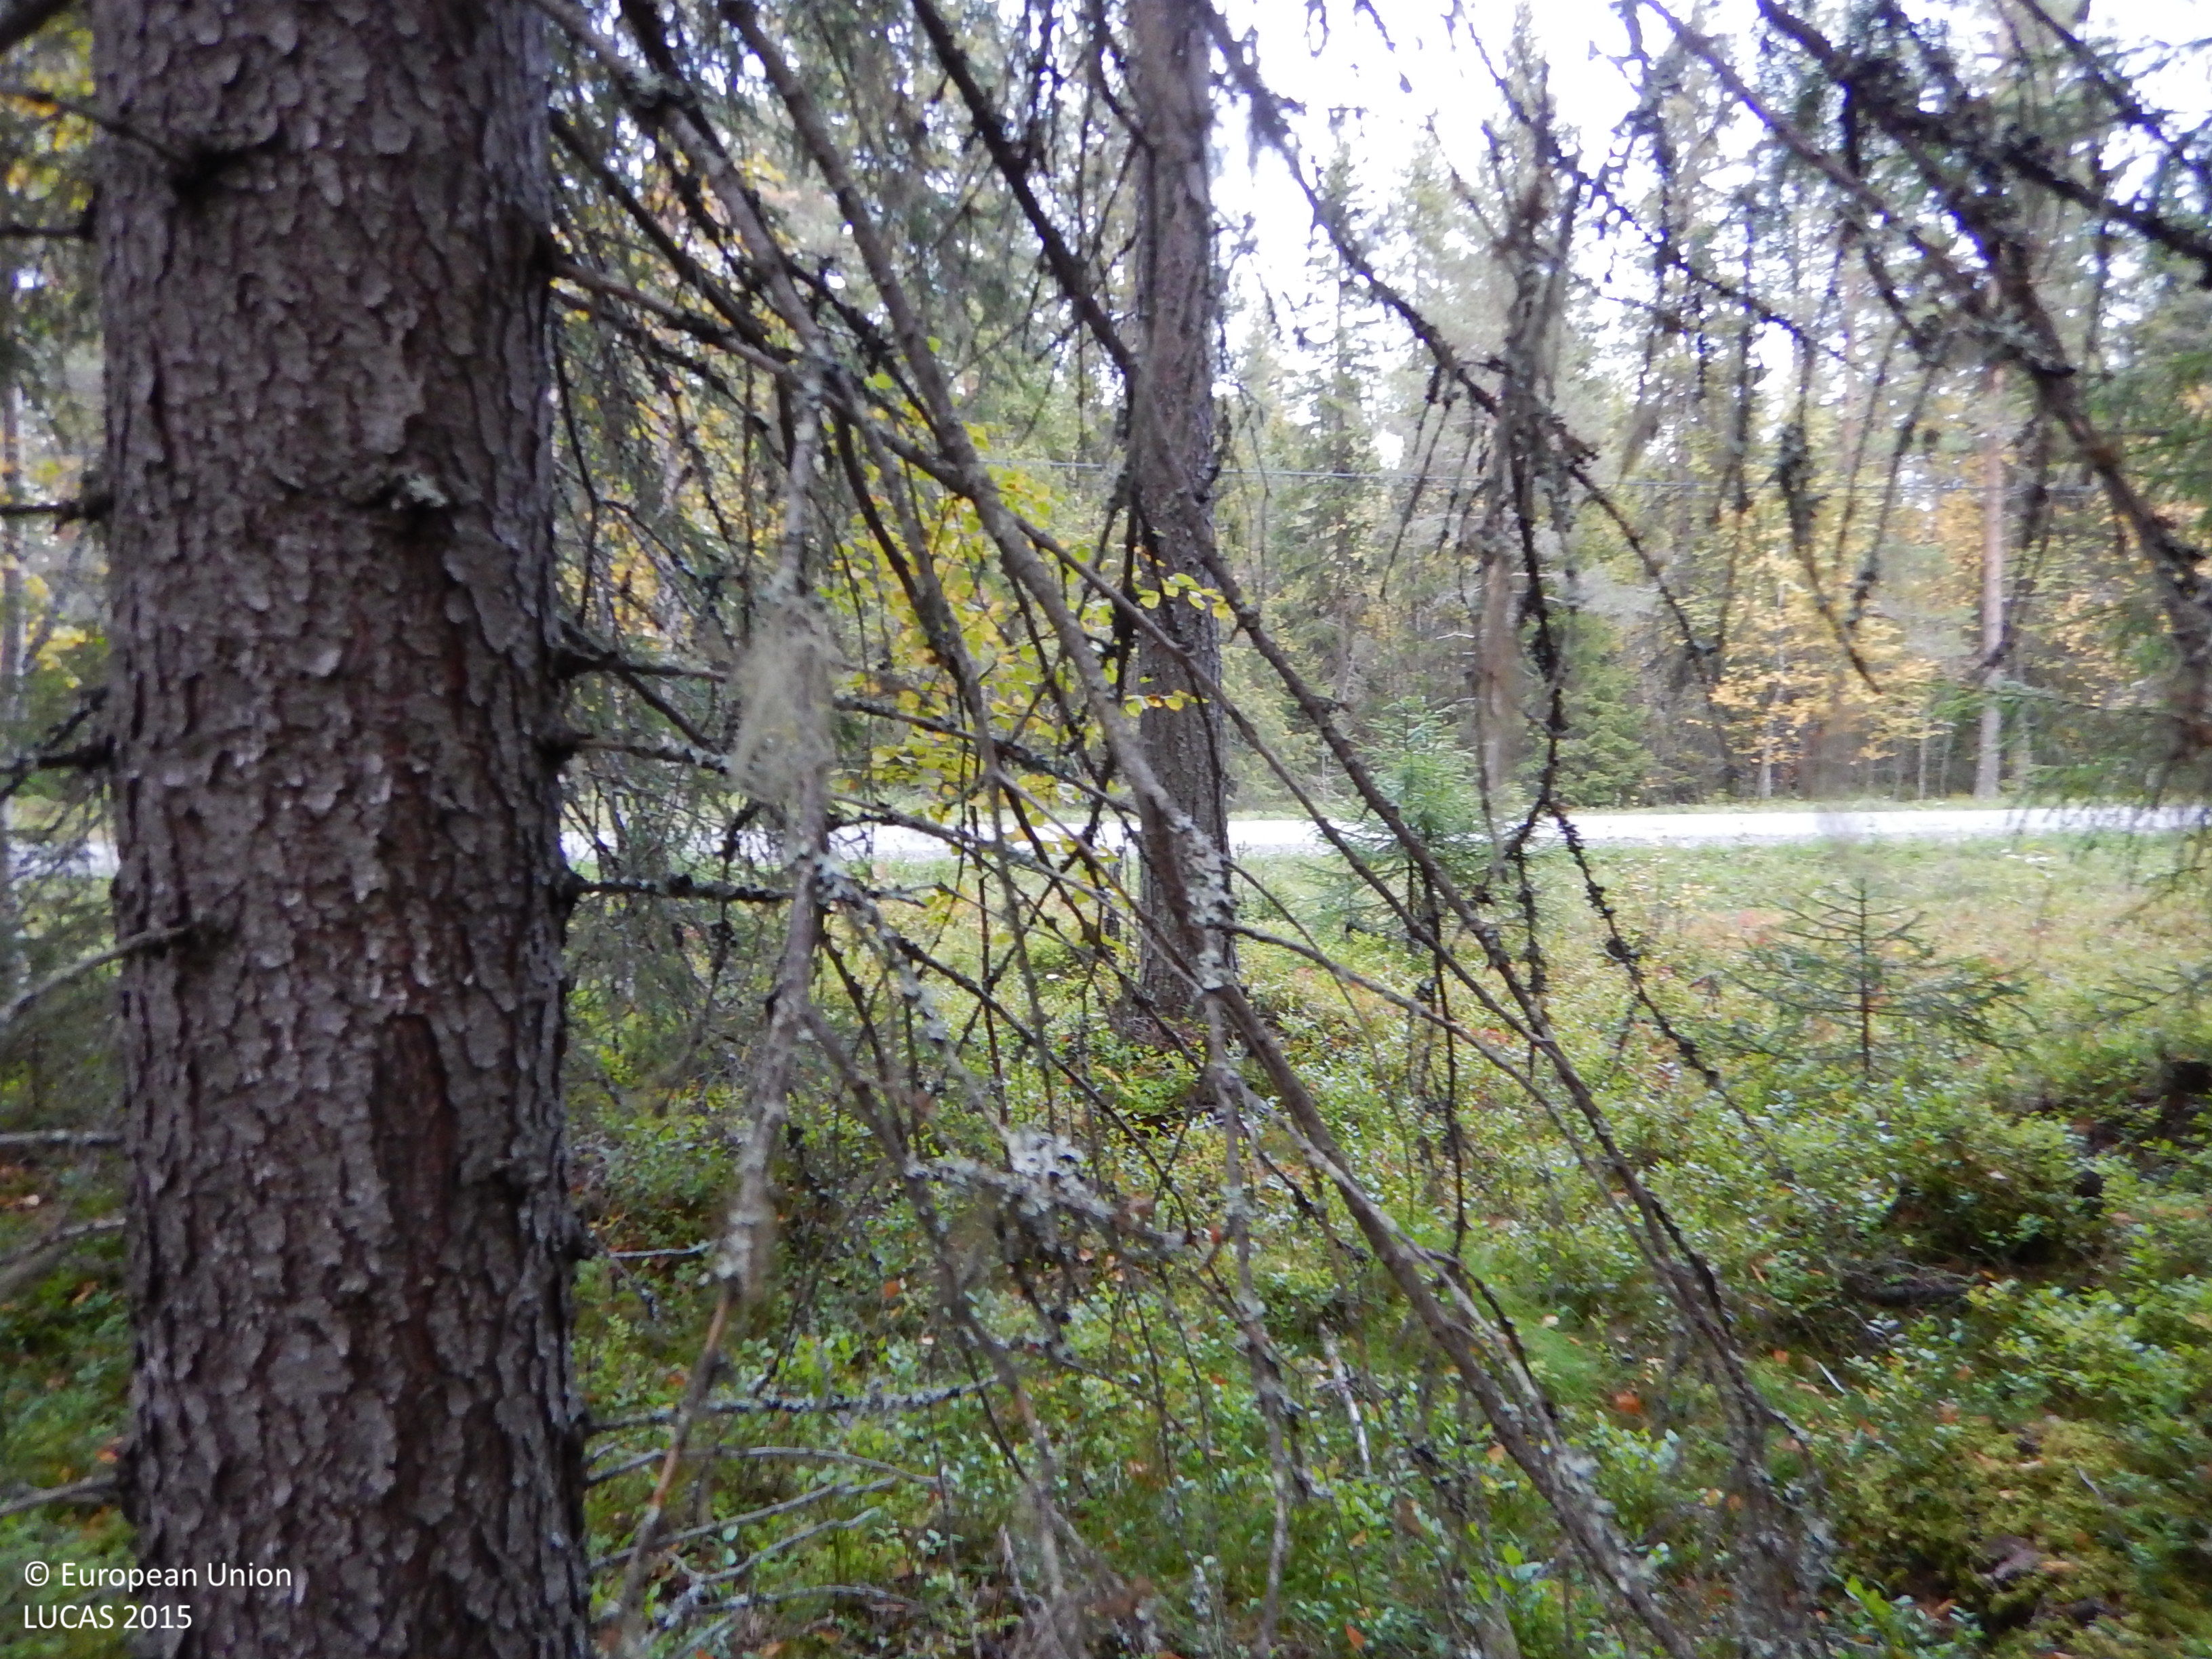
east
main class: Woodland
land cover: Other coniferous woodland
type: boreal forest
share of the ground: 50 - 75 %
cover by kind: coniferous forest trees 45 %, shrubs 25 %, broadleaved forest trees 15 %, lichens and mosses 15 %
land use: Forestry
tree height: > 5 m
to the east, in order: Other coniferous woodland; Ditches and canals; Grass margins; Paved roads, cycling and walking lanes; Grass margins; Ditches and canals; Electric lines; Pine dominated mixed woodland; Other coniferous woodland
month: September
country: SE
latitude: 64.7490
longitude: 20.1201
